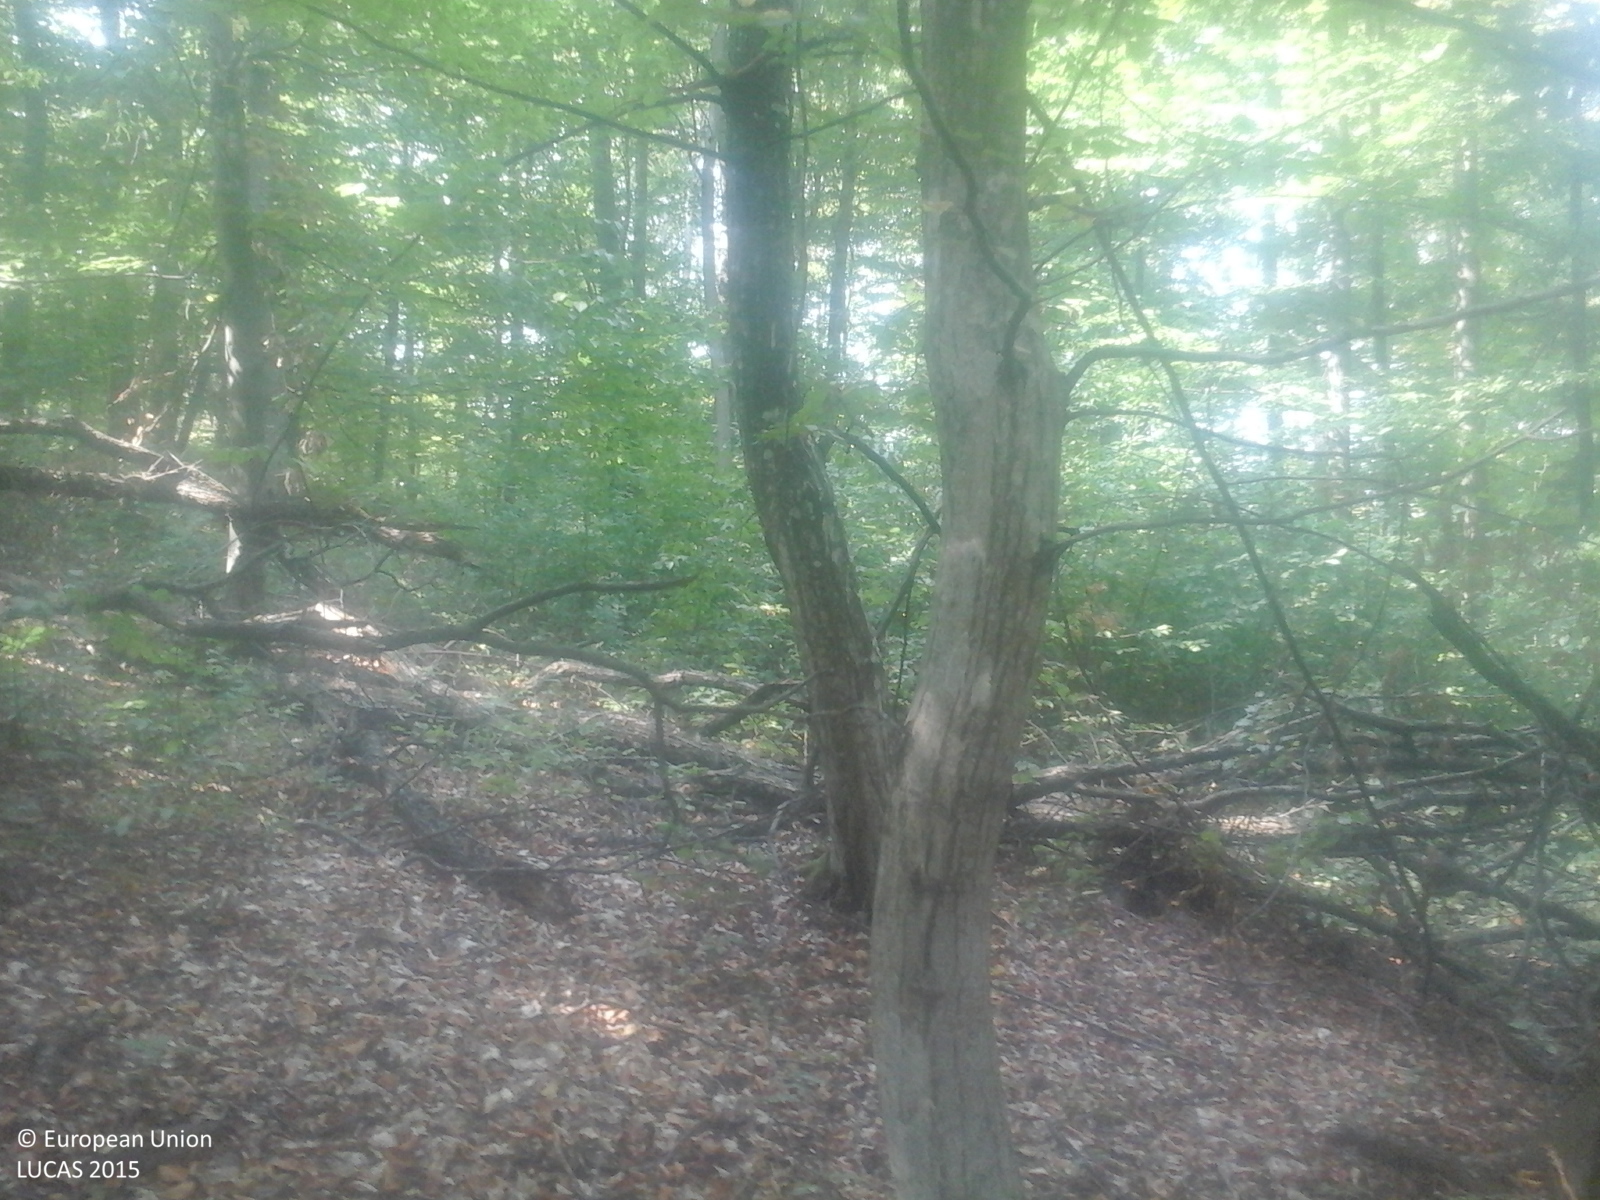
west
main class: Woodland
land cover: Broadleaved woodland
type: beech forest
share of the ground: > 75 %
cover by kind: broadleaved forest trees 100 %
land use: Forestry
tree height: > 5 m
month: September
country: RO
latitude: 47.5008
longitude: 23.7657
